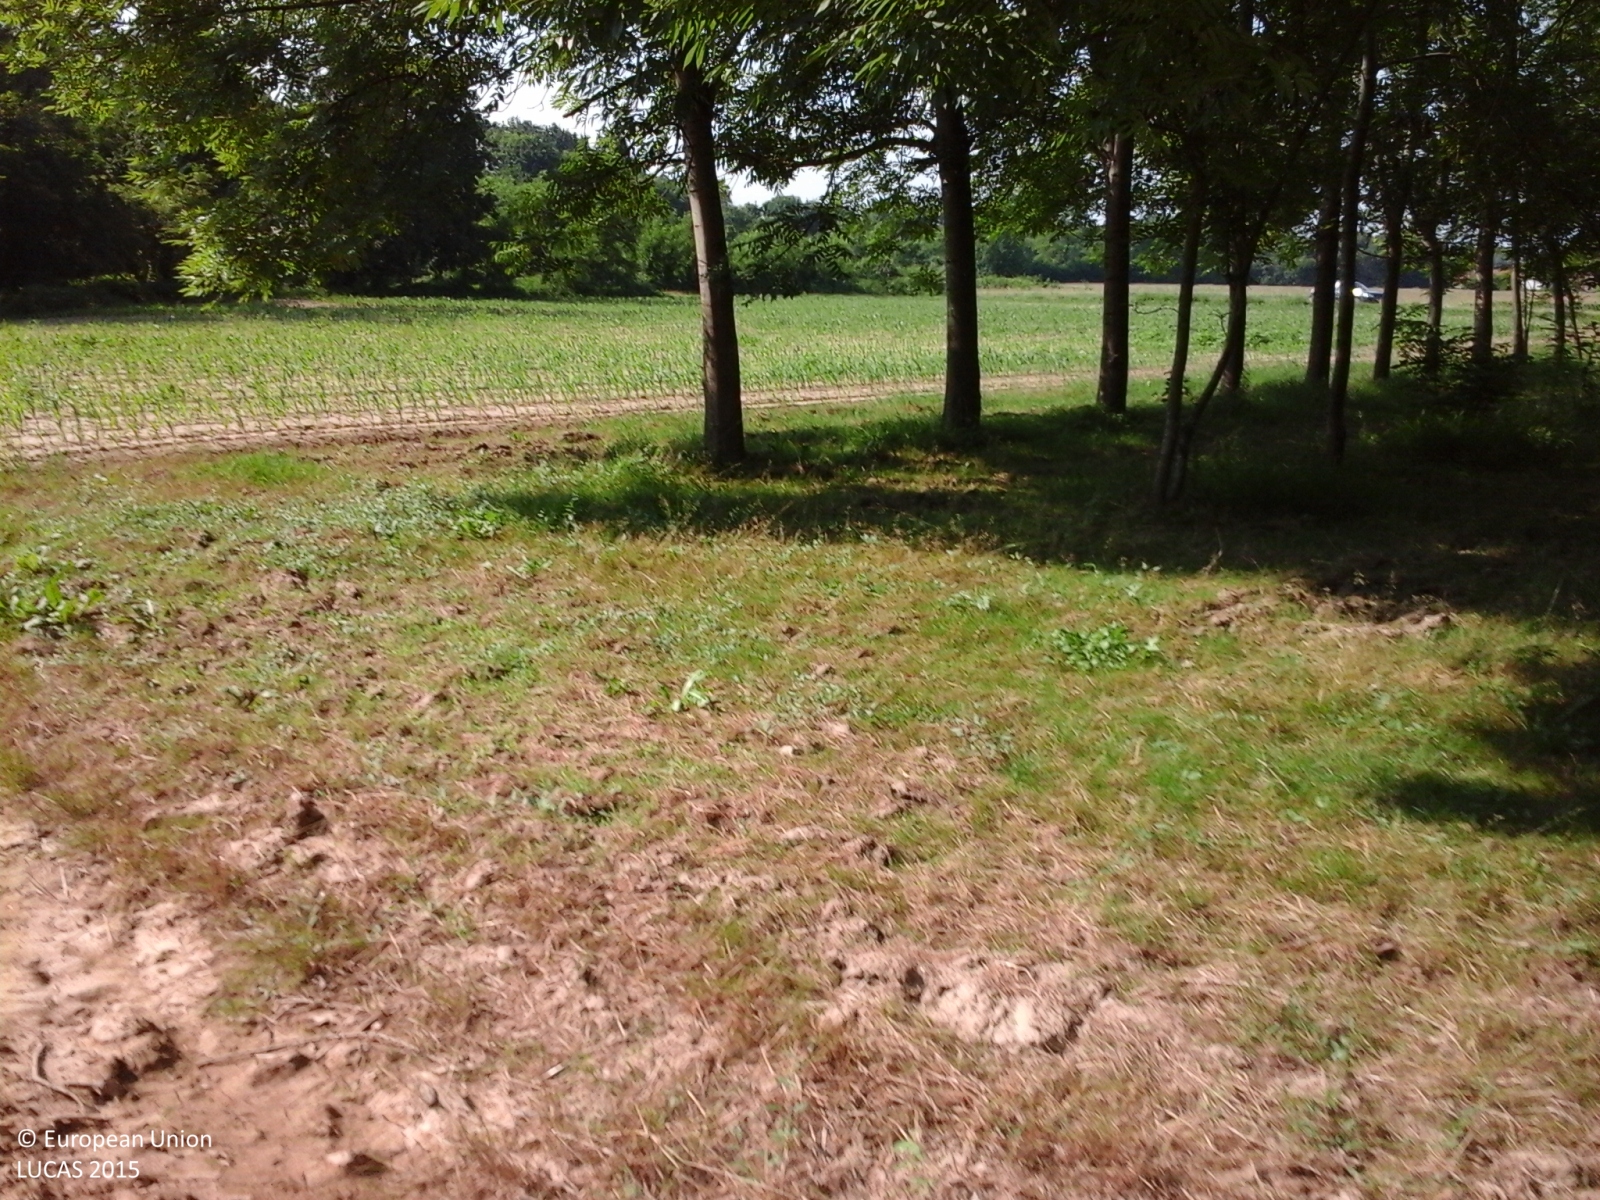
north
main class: Cropland
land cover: Maize
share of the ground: 10 - 25 %
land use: Agriculture (excluding fallow land and kitchen gardens)
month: June
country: IT
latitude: 45.2111
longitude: 7.8010
